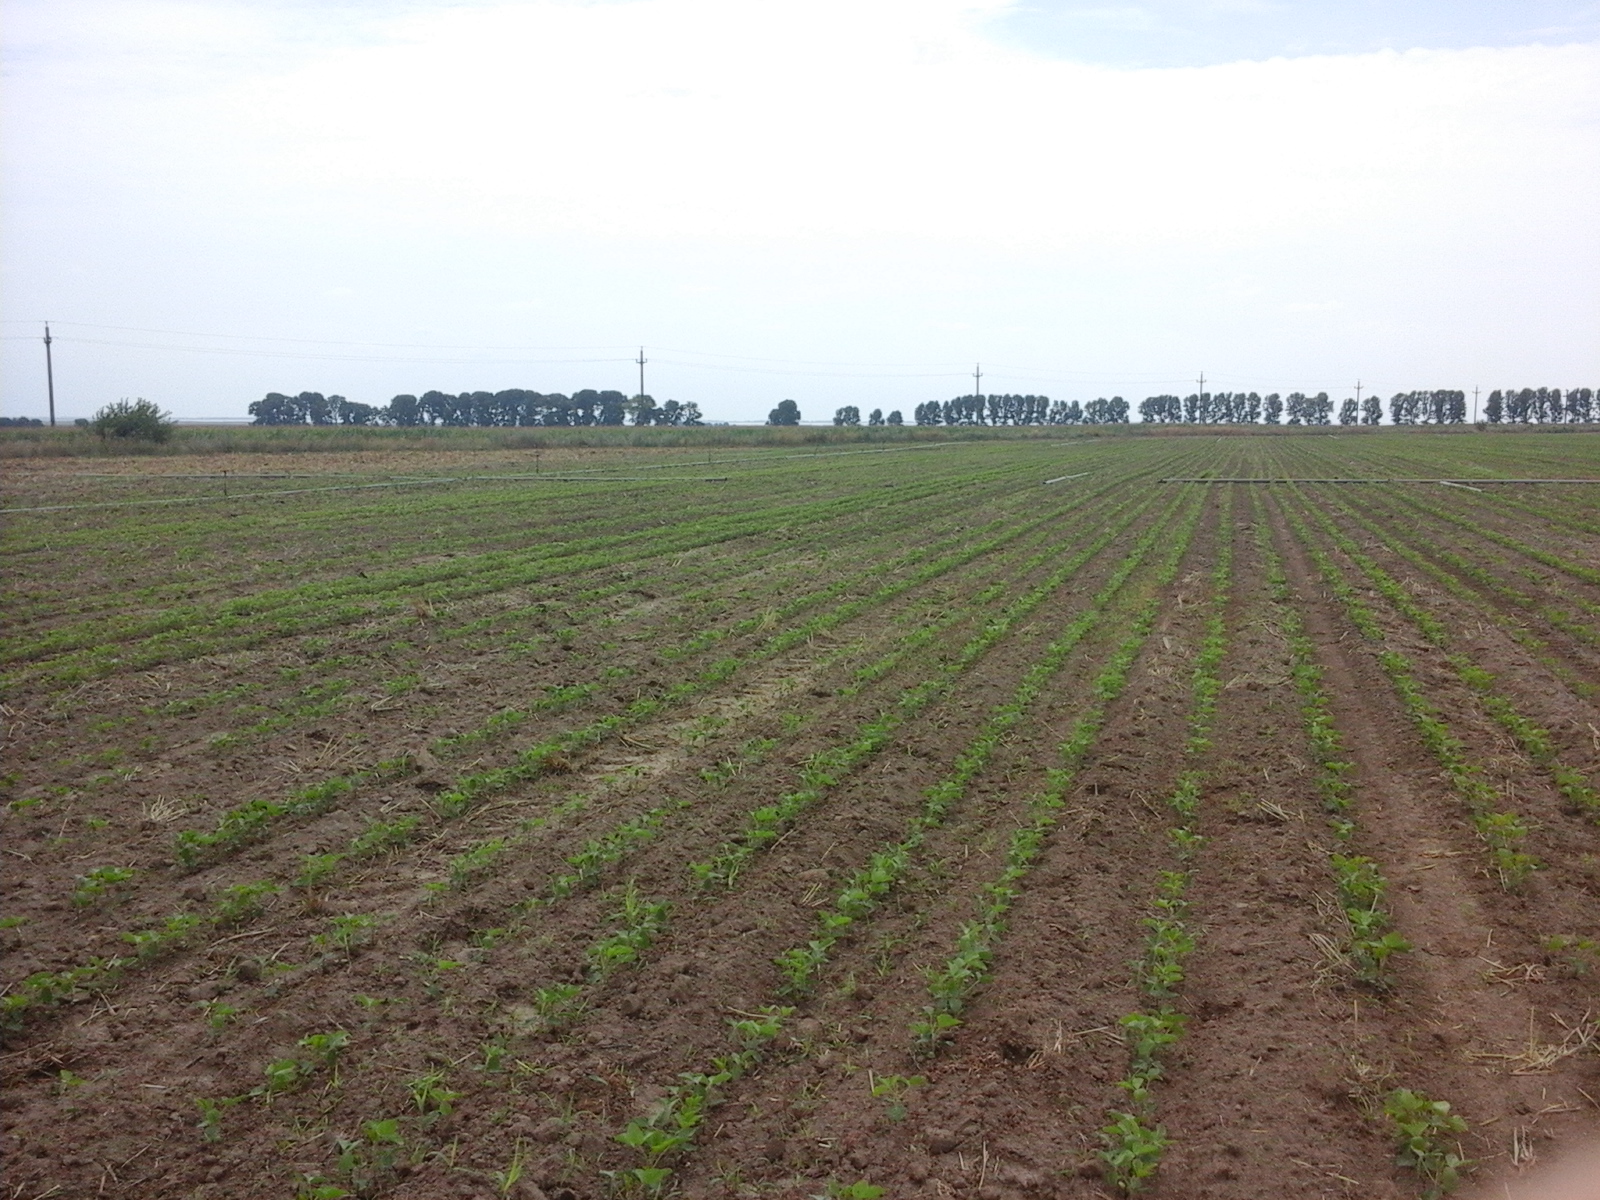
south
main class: Cropland
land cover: Soya
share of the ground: 10 - 25 %
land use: Agriculture (excluding fallow land and kitchen gardens)
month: August
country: RO
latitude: 45.0349
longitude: 28.9961
